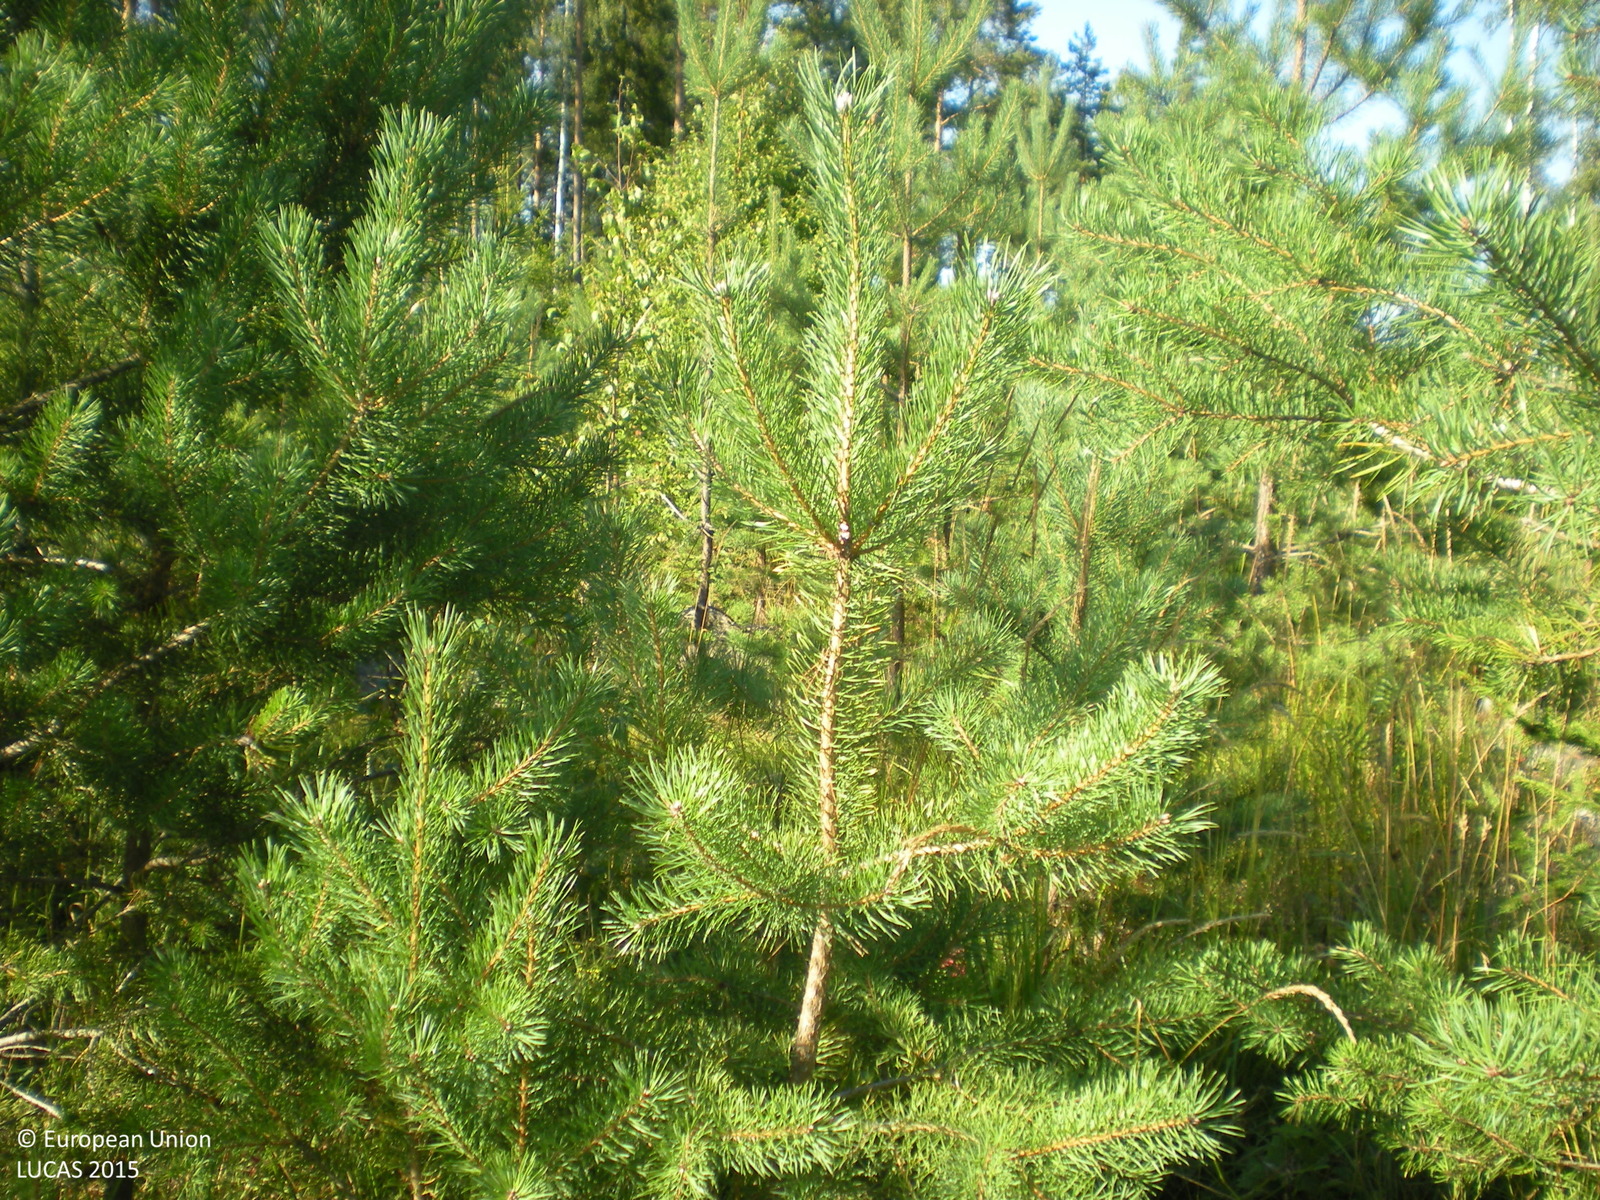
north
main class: Woodland
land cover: Pine dominated mixed woodland
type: boreal forest
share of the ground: 50 - 75 %
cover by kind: coniferous forest trees 45 %, herbaceous plants 35 %, broadleaved forest trees 20 %
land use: Forestry
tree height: < 5 m
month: August
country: SE
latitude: 60.5738
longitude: 17.2338
